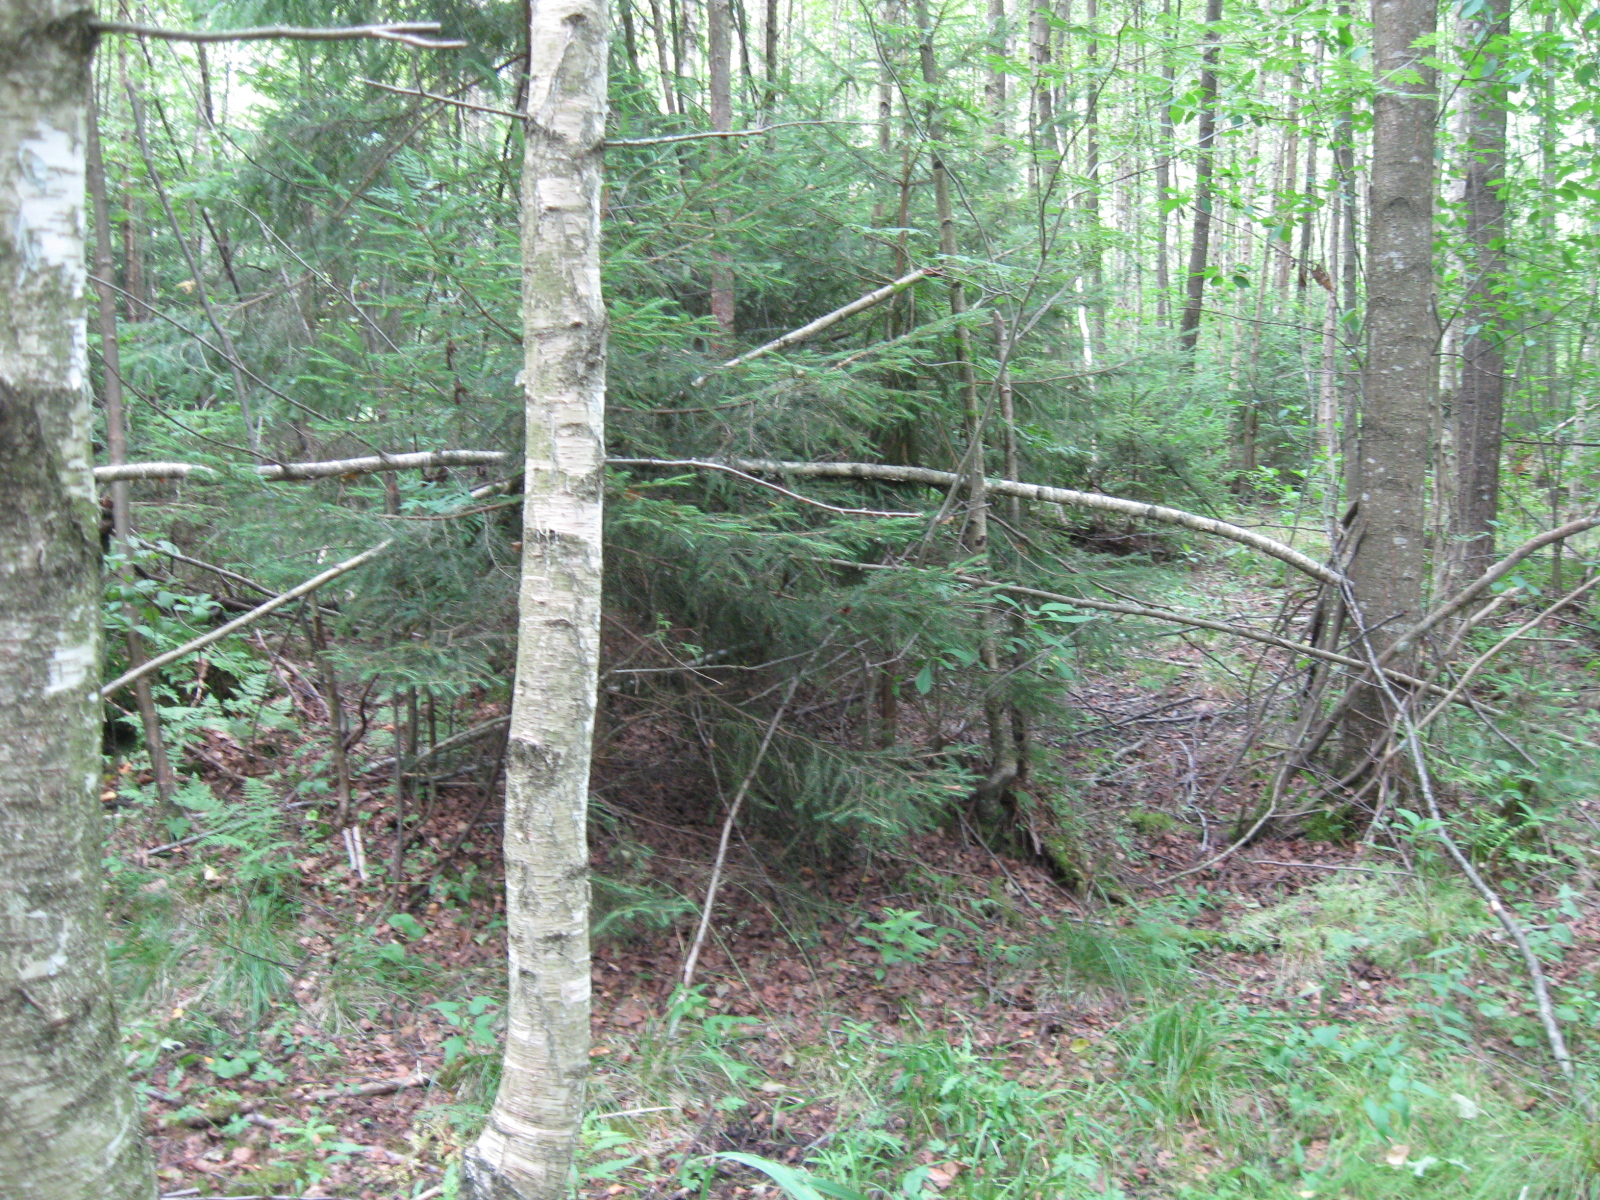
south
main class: Woodland
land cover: Broadleaved woodland
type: non-riverine alder, birch or aspen forest
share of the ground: > 75 %
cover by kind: broadleaved forest trees 75 %, herbaceous plants 10 %, coniferous forest trees 5 %, shrubs 5 %, lichens and mosses 5 %
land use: Forestry
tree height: > 5 m
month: July
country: LT
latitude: 54.7698
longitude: 23.5591
